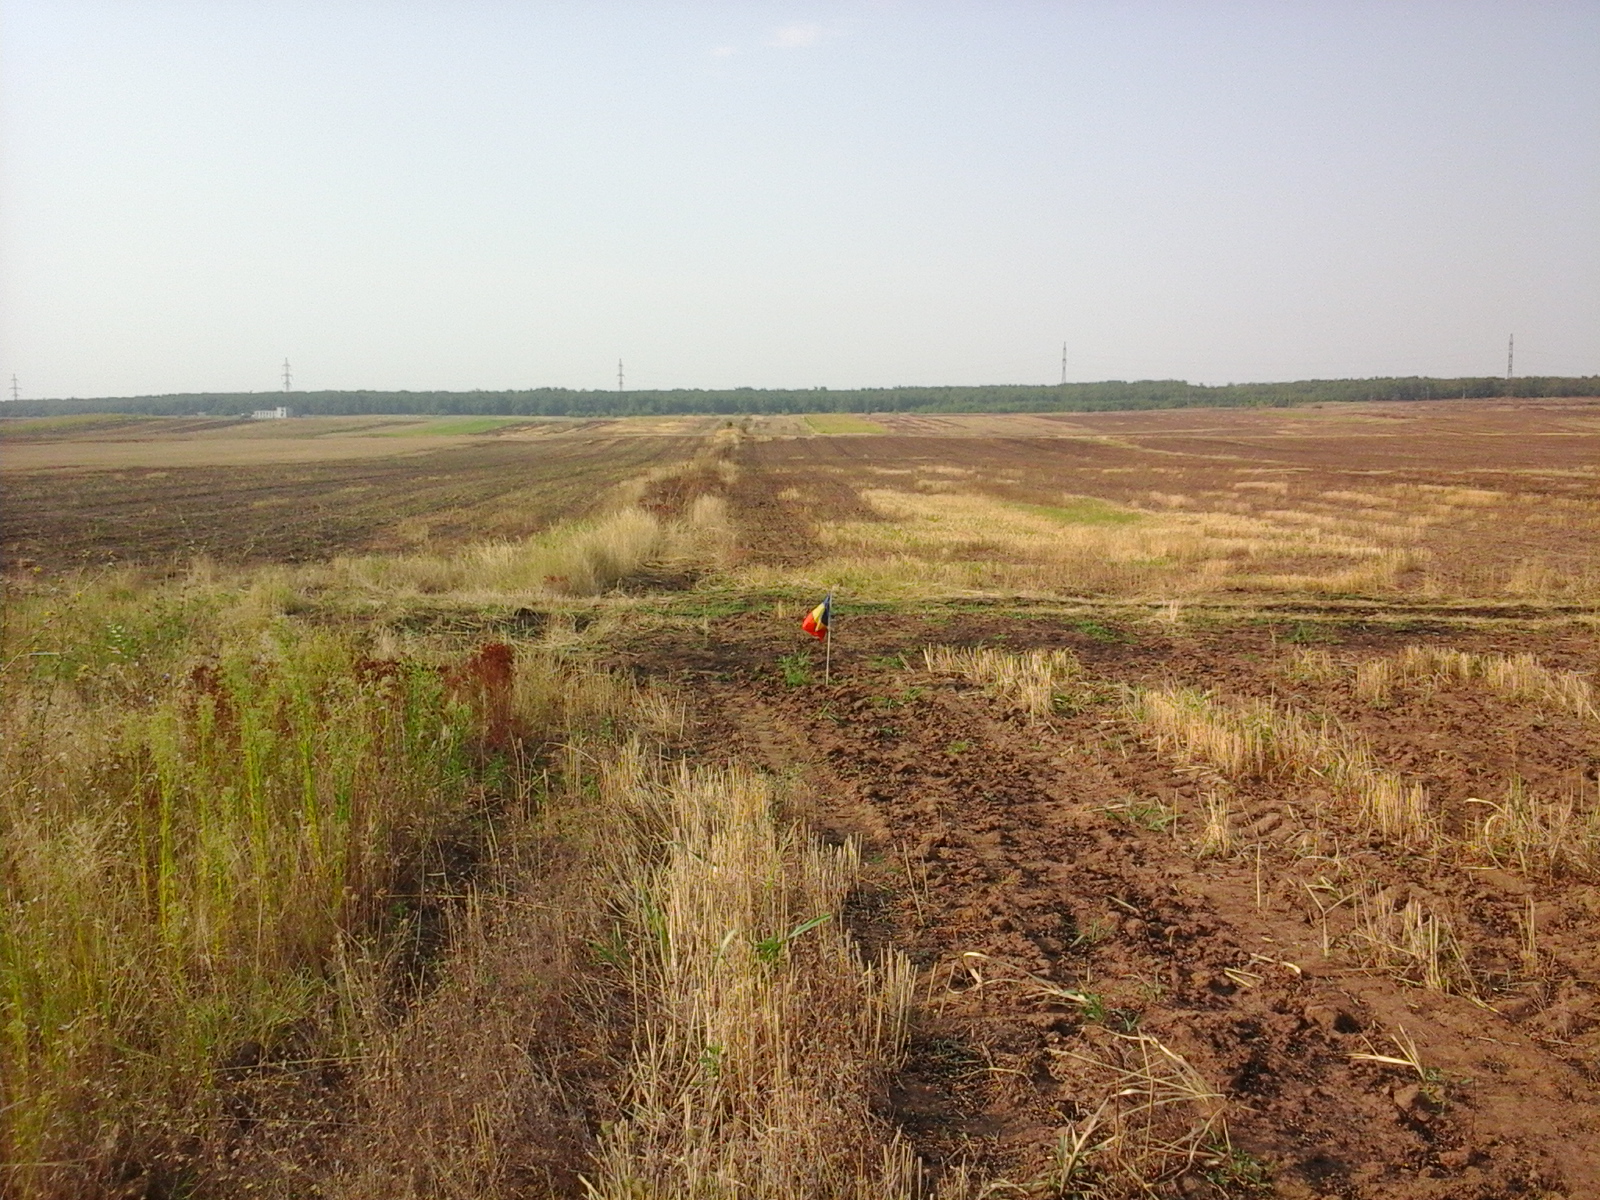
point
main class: Cropland
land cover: Barley
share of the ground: < 10 %
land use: Agriculture (excluding fallow land and kitchen gardens)
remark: Burnt area
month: August
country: RO
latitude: 44.2950
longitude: 22.7107
